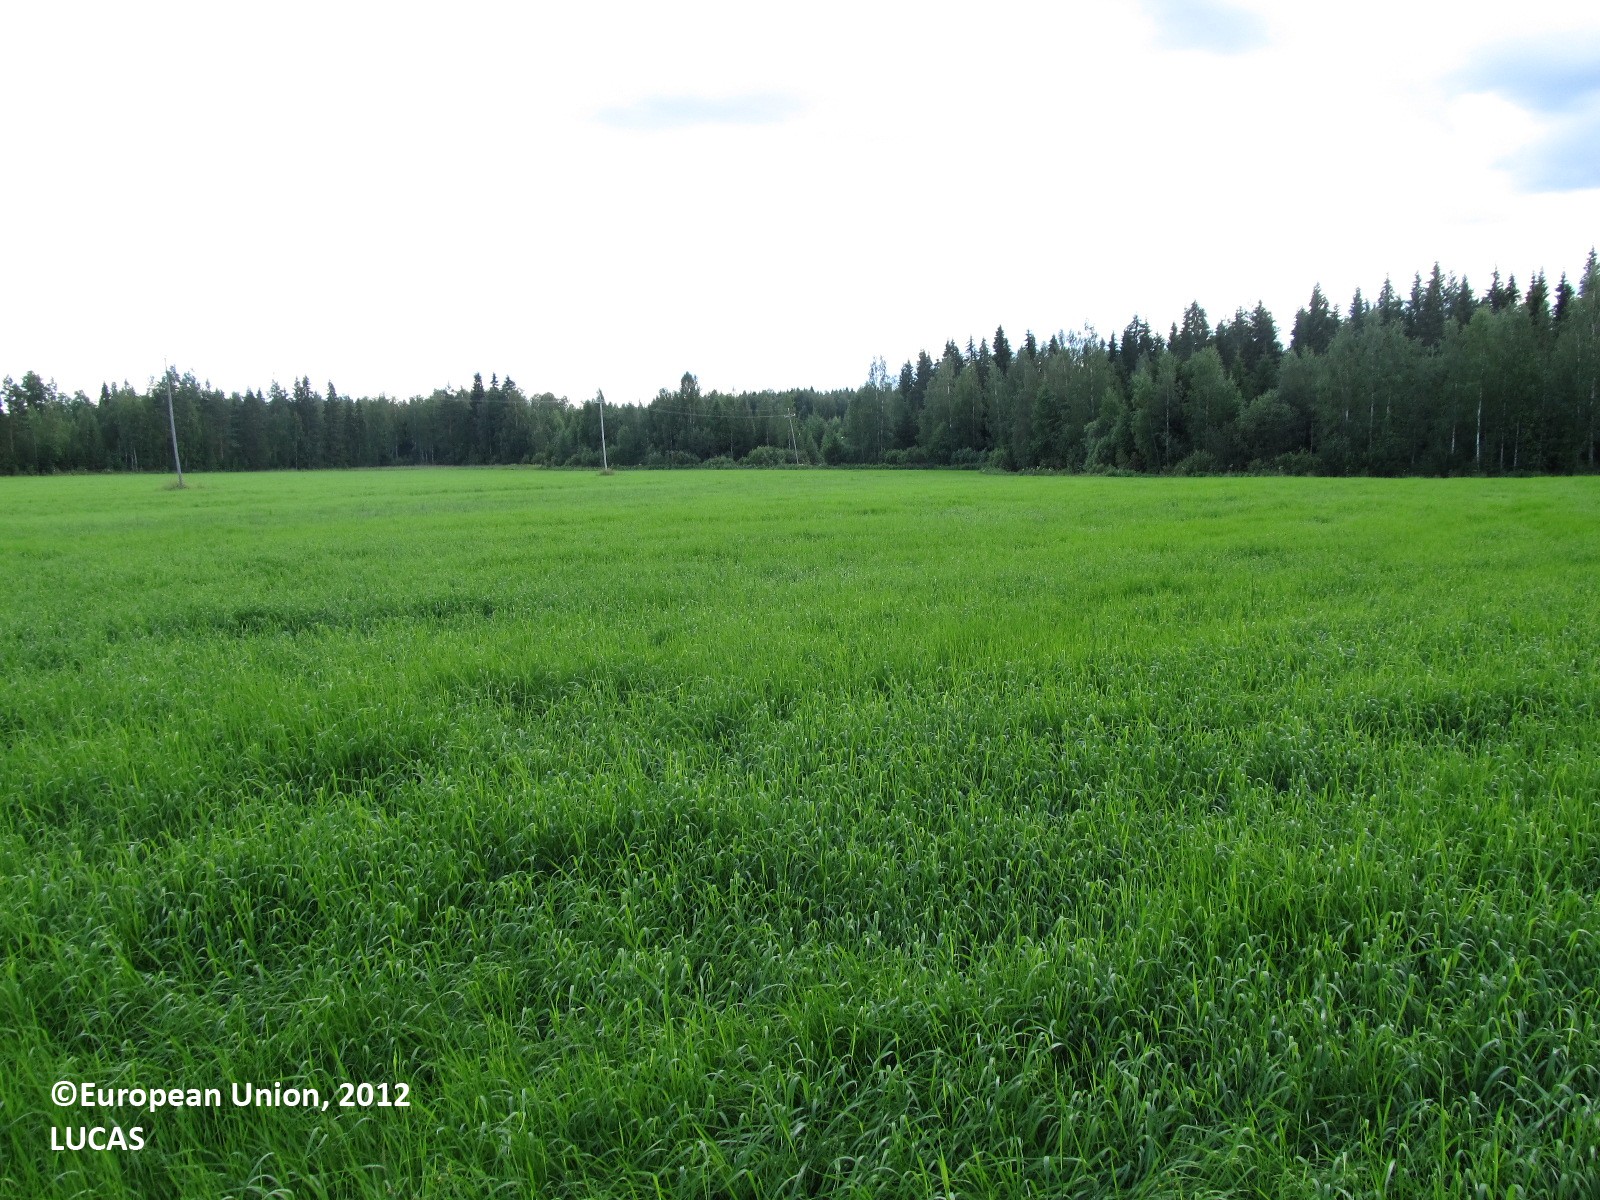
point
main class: Cropland
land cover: Temporary grasslands
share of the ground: > 75 %
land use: Agriculture (excluding fallow land and kitchen gardens)
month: July
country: FI
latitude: 62.0154
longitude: 28.2900
